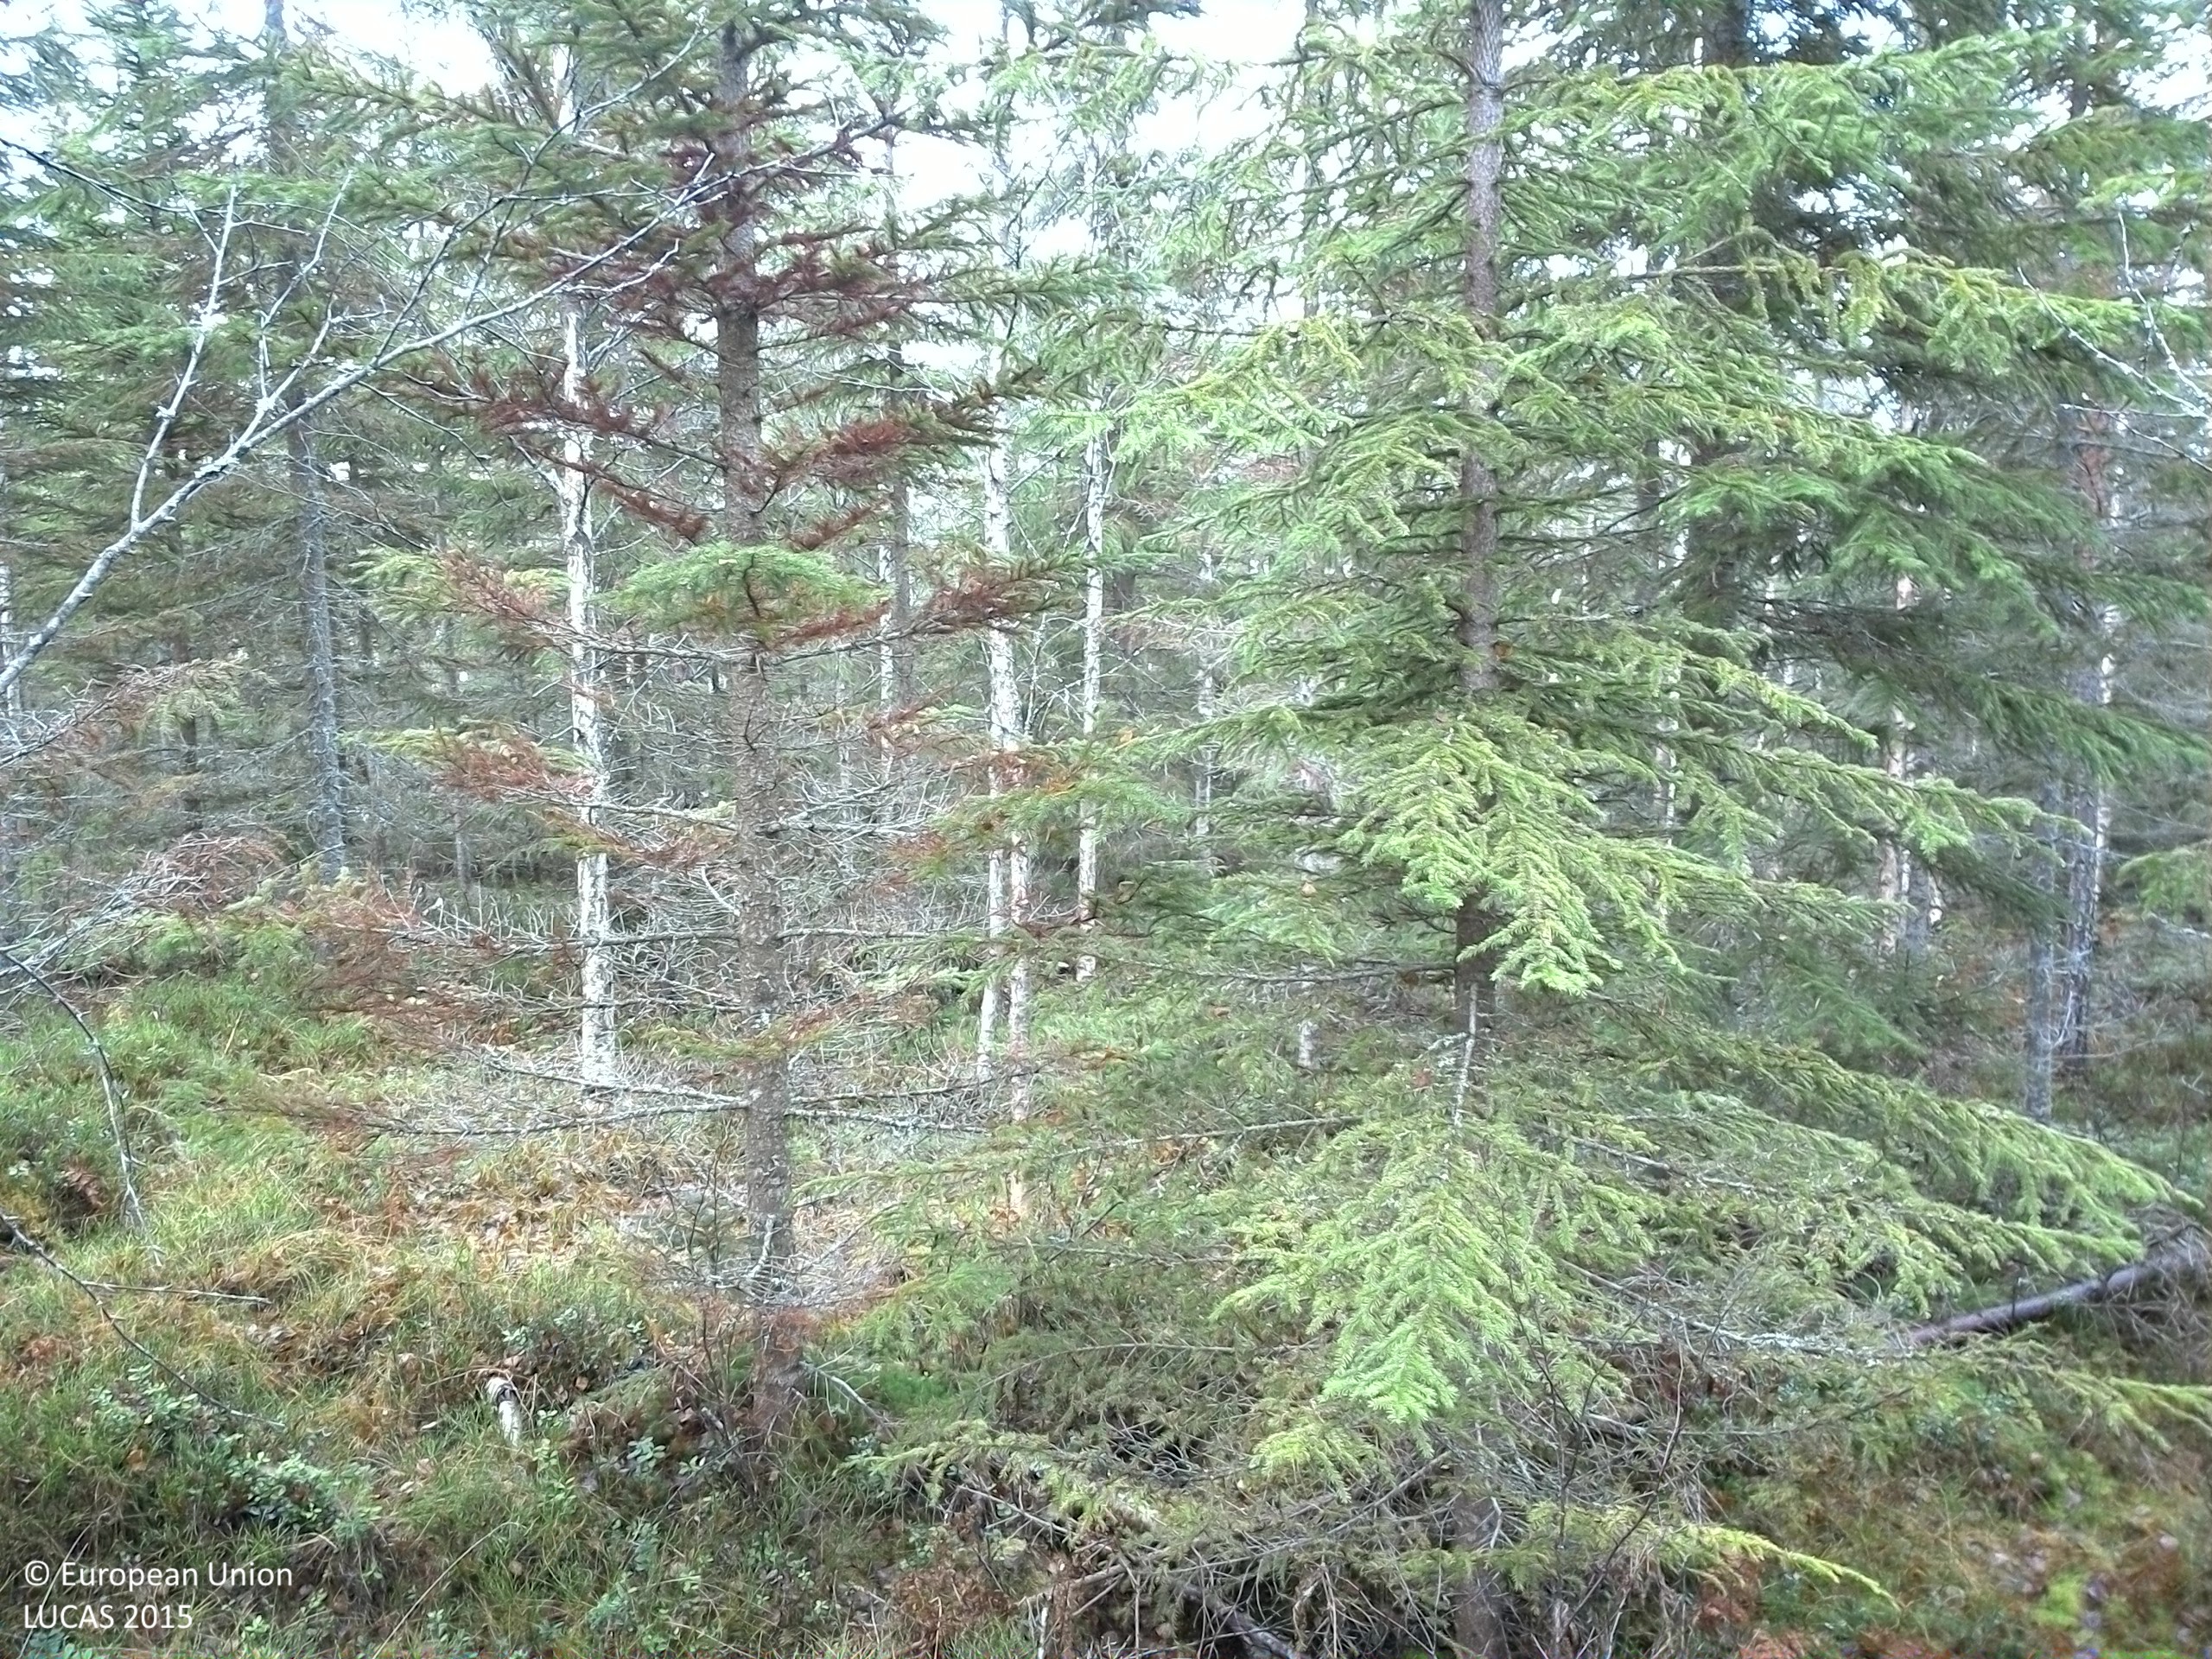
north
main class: Woodland
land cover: Spruce dominated mixed woodland
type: boreal forest
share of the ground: > 75 %
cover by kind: coniferous forest trees 55 %, broadleaved forest trees 20 %, shrubs 20 %, lichens and mosses 5 %
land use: Forestry
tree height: > 5 m
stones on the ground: < 10 %
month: November
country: SE
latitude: 60.2669
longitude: 14.6343
